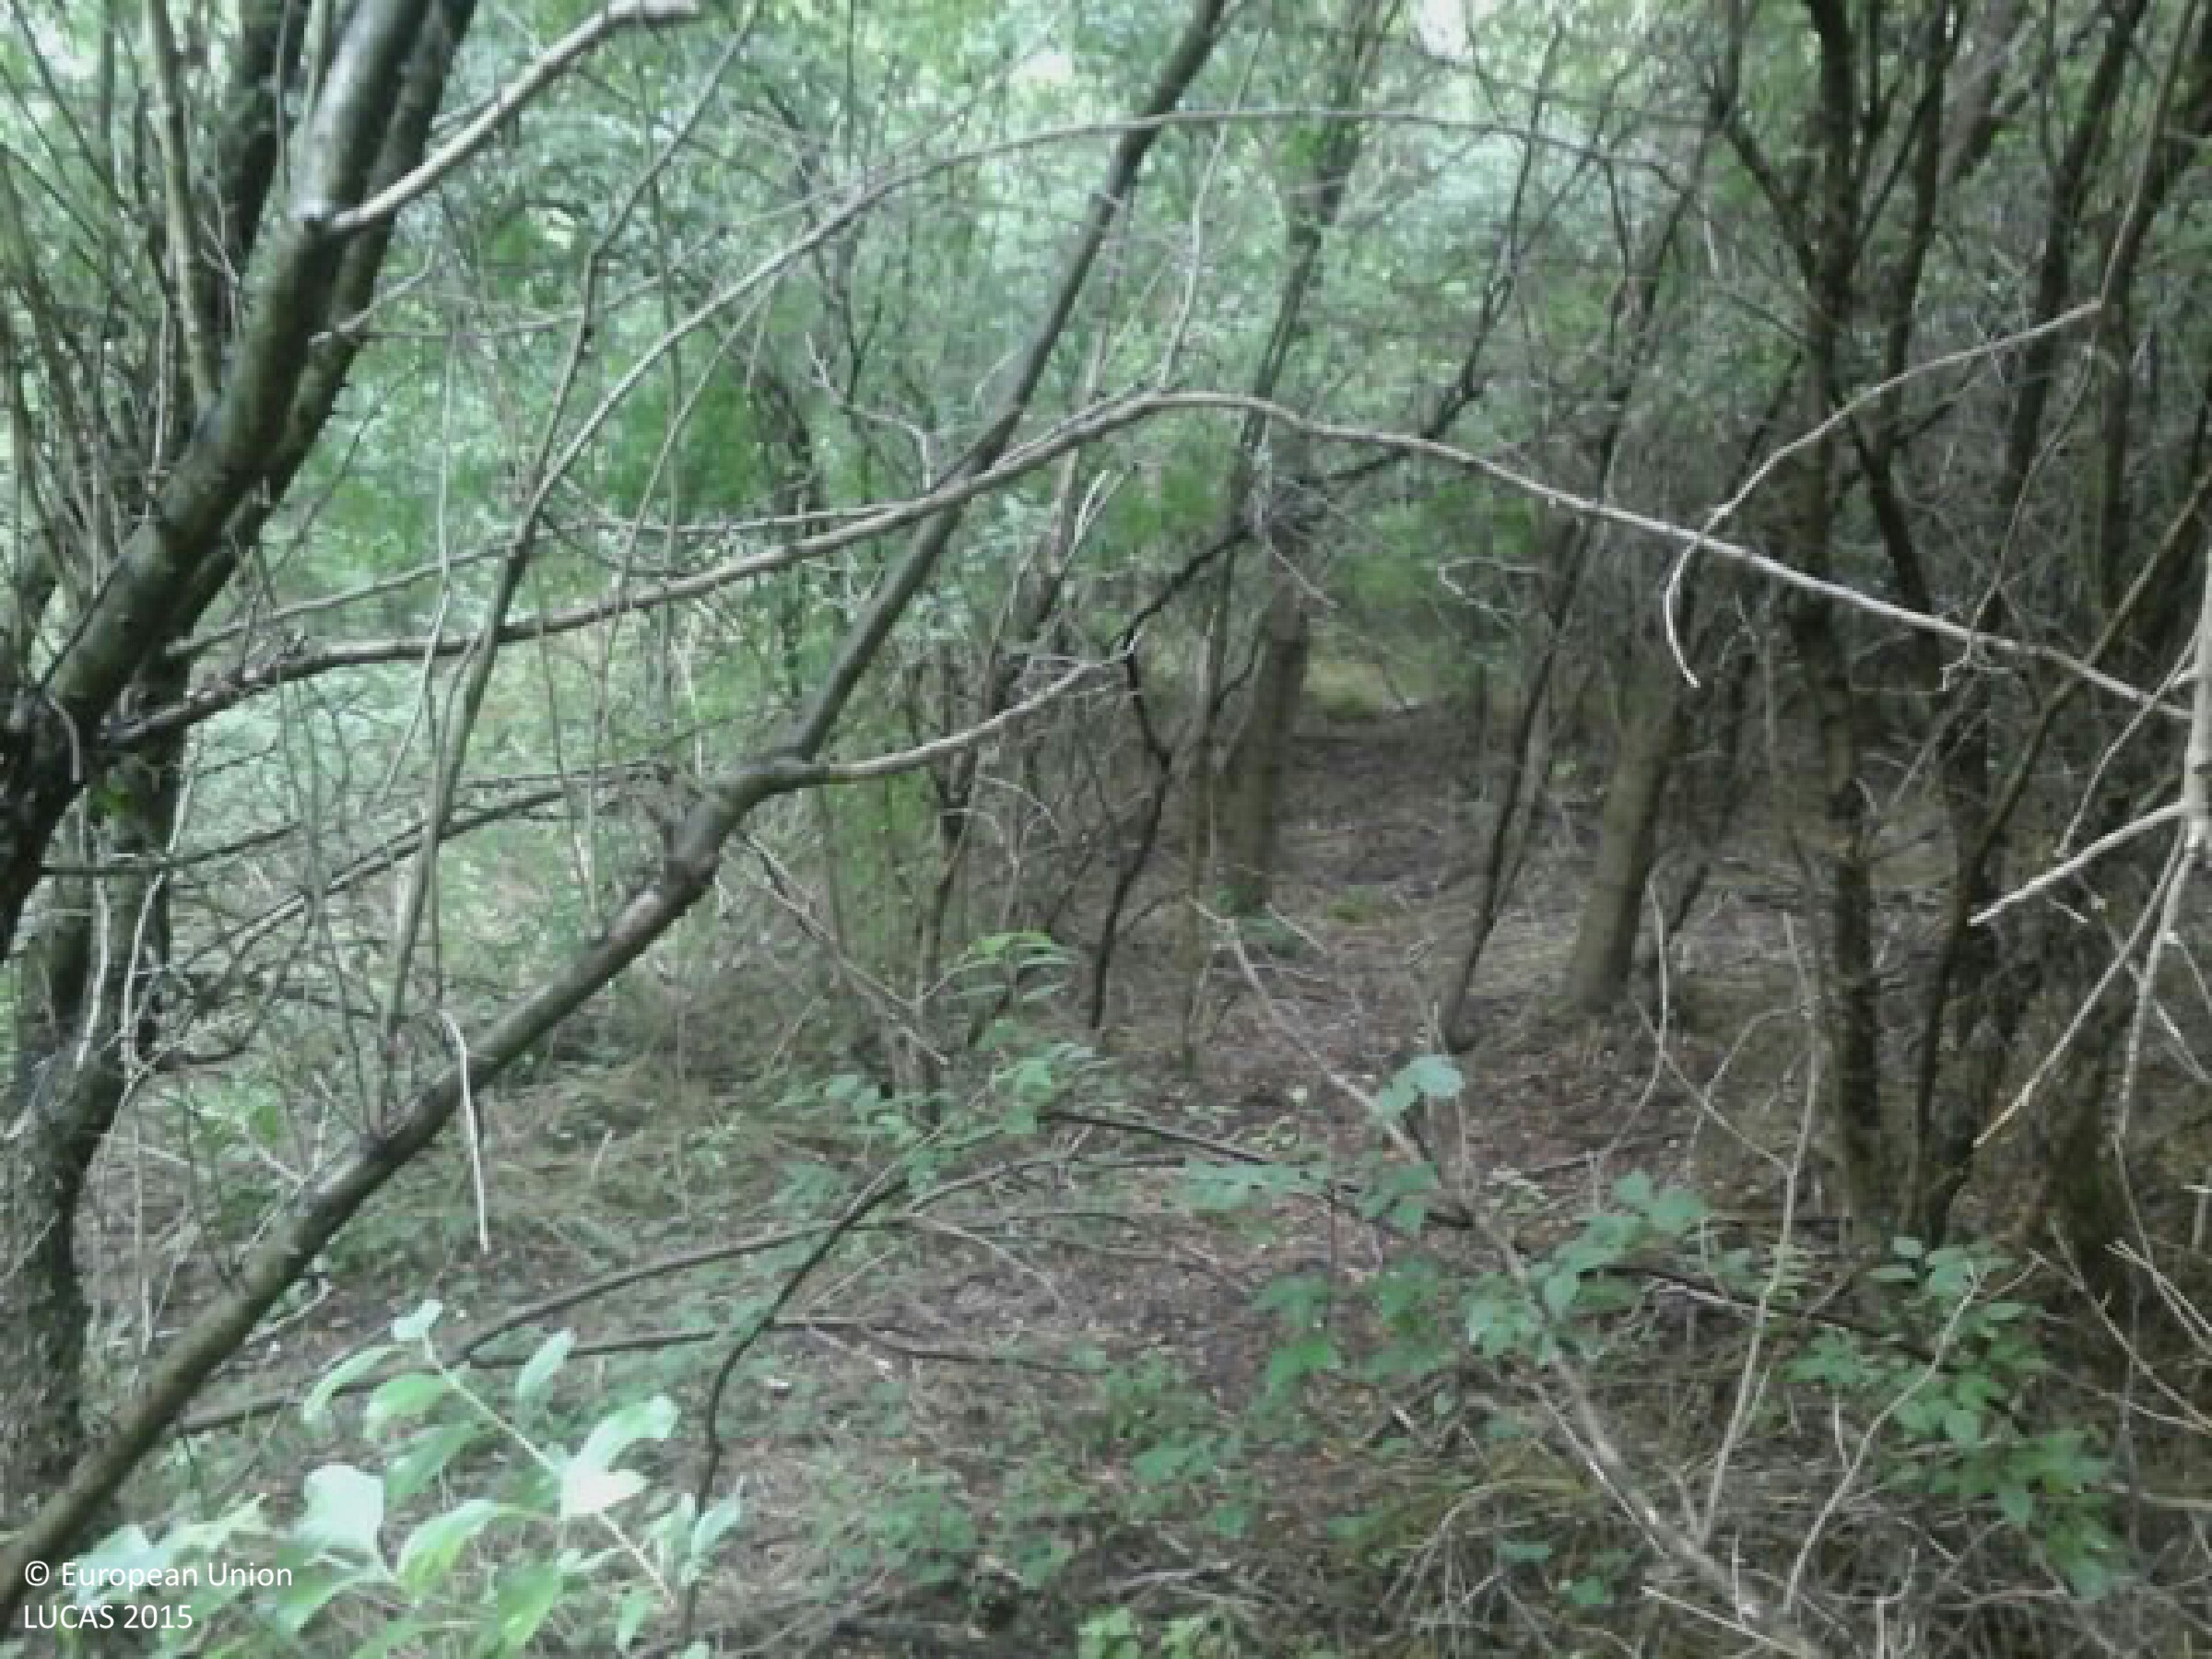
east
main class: Woodland
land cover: Broadleaved woodland
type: mesophytic deciduous forest
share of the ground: > 75 %
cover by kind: broadleaved forest trees 80 %, herbaceous plants 20 %
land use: Forestry
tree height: > 5 m
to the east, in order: Broadleaved woodland; Shrubland with sparse tree cover; Fences; Broadleaved woodland
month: June
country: HU
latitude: 46.2429
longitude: 19.0003
